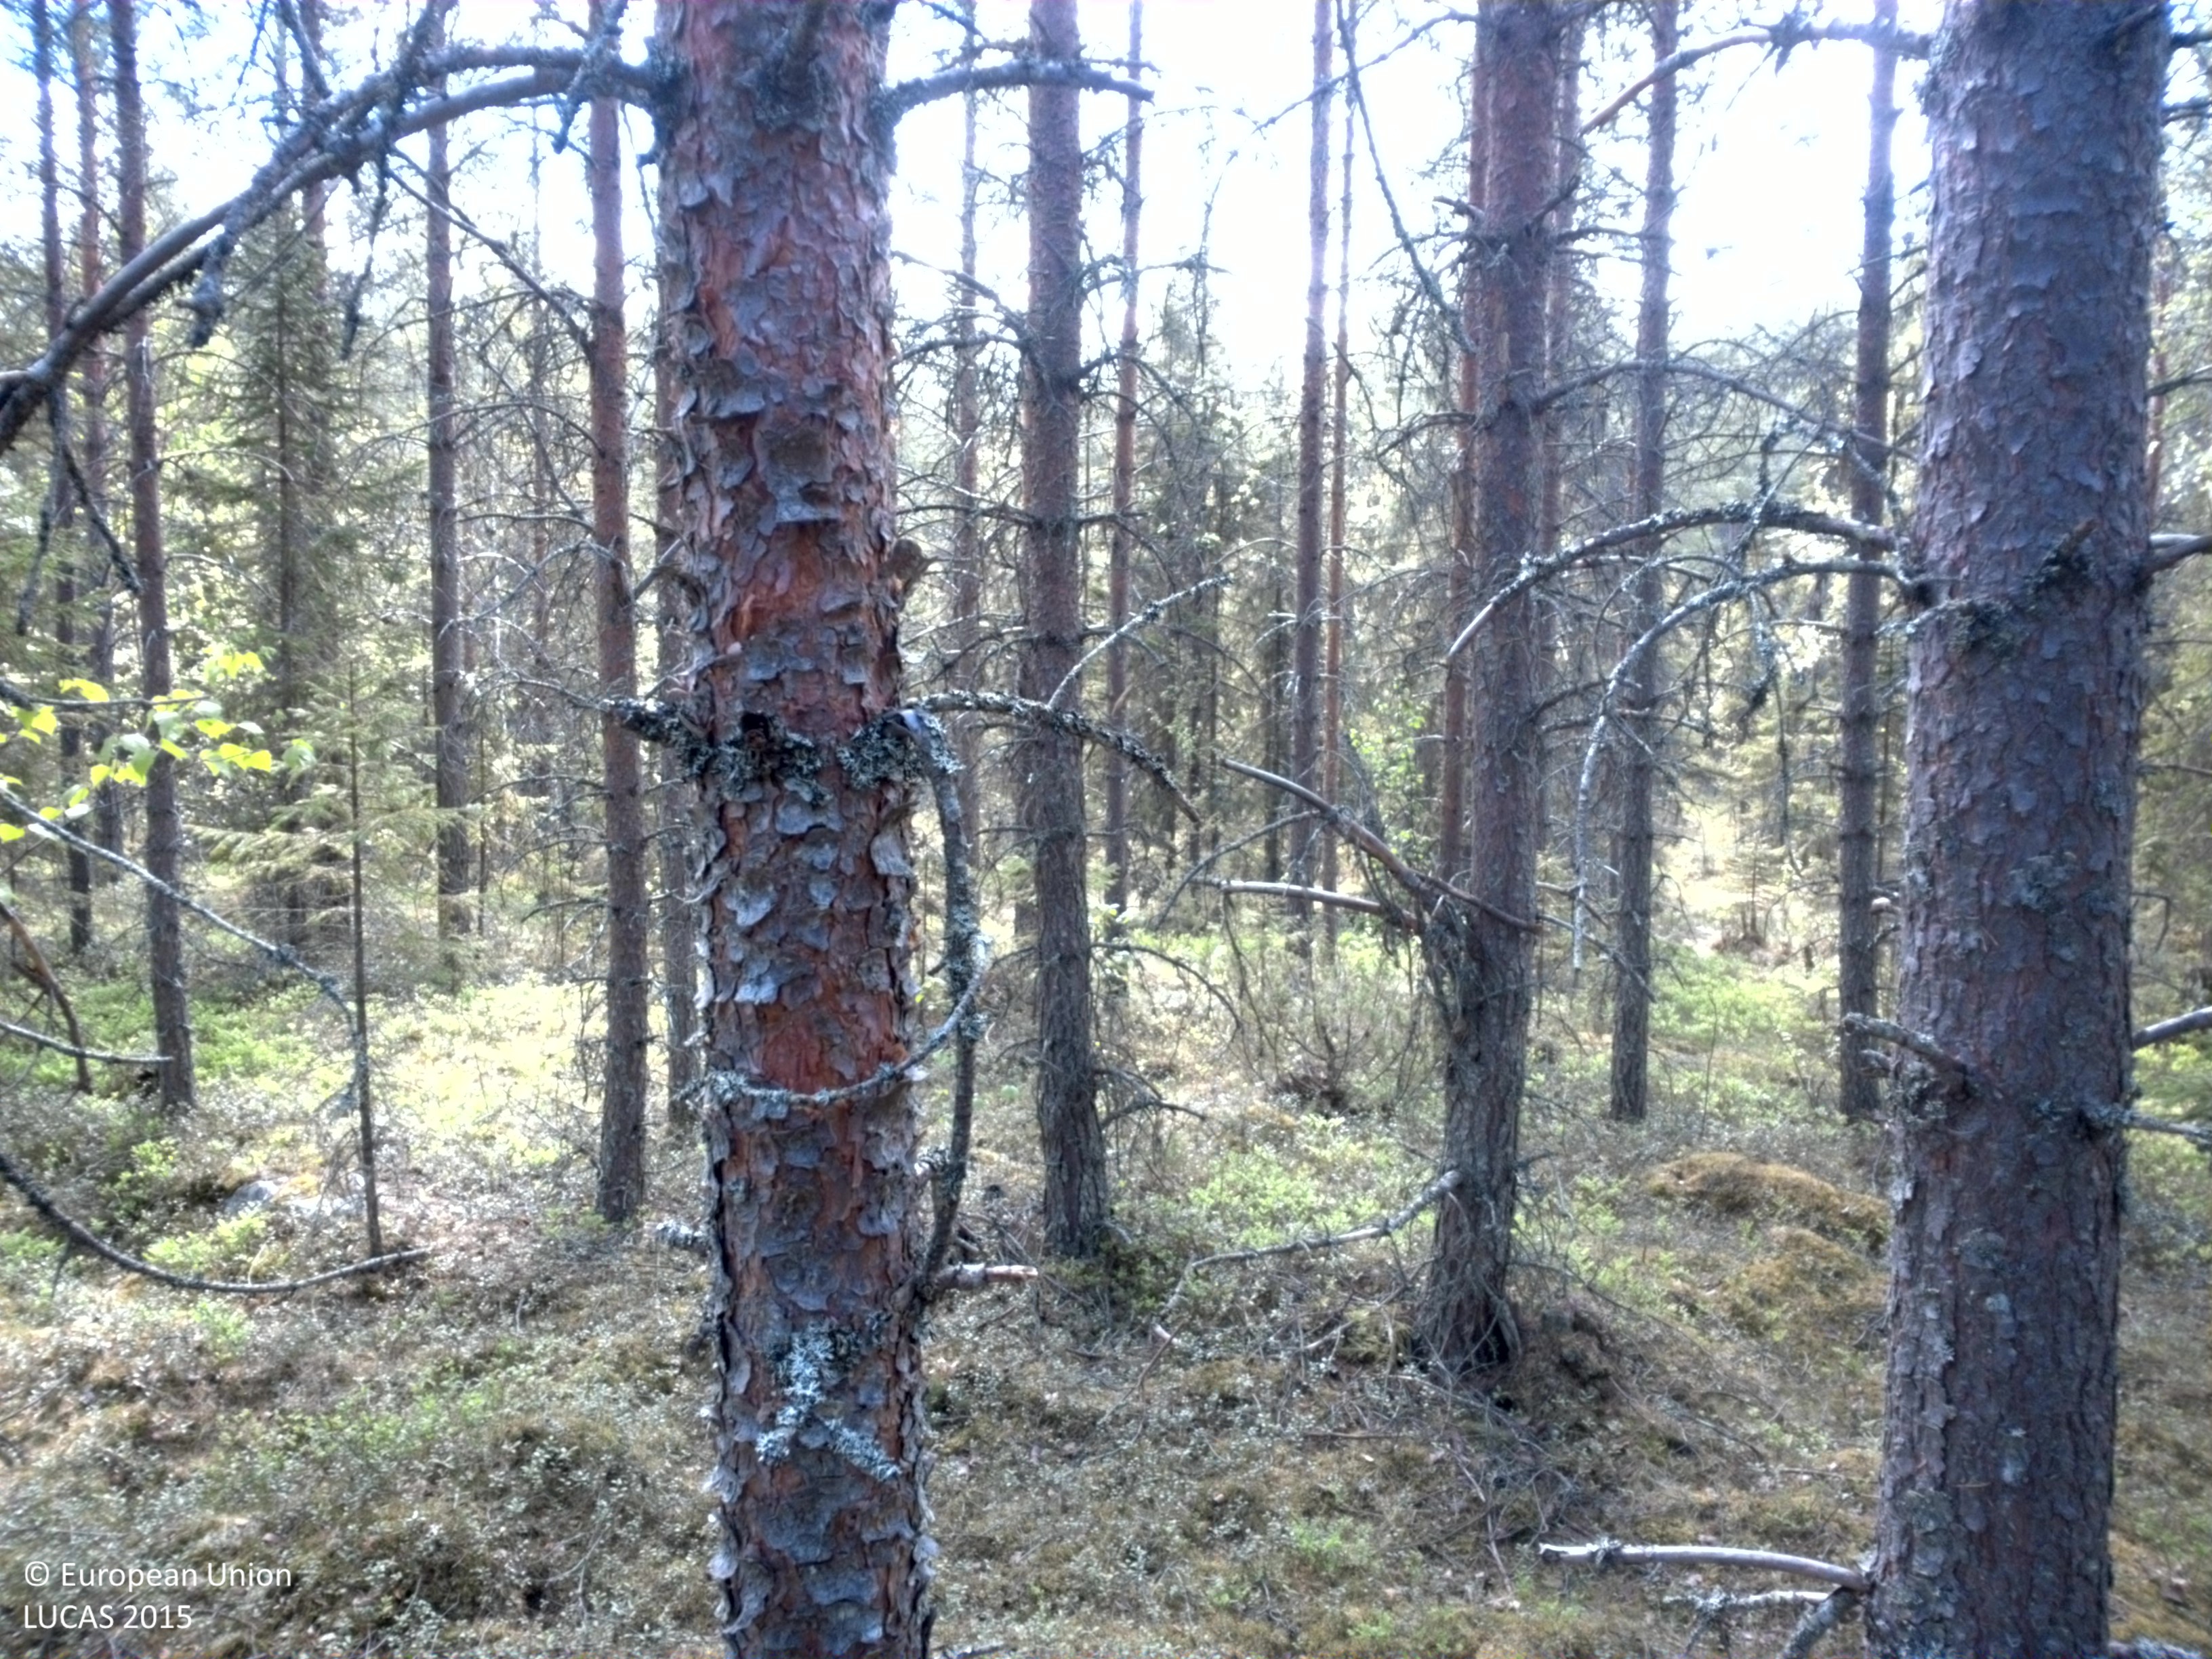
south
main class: Woodland
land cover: Pine dominated coniferous woodland
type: boreal forest
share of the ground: 50 - 75 %
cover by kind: coniferous forest trees 45 %, lichens and mosses 25 %, herbaceous plants 15 %, broadleaved forest trees 10 %, shrubs 5 %
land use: Forestry
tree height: > 5 m
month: June
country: SE
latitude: 64.2505
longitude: 17.2515
